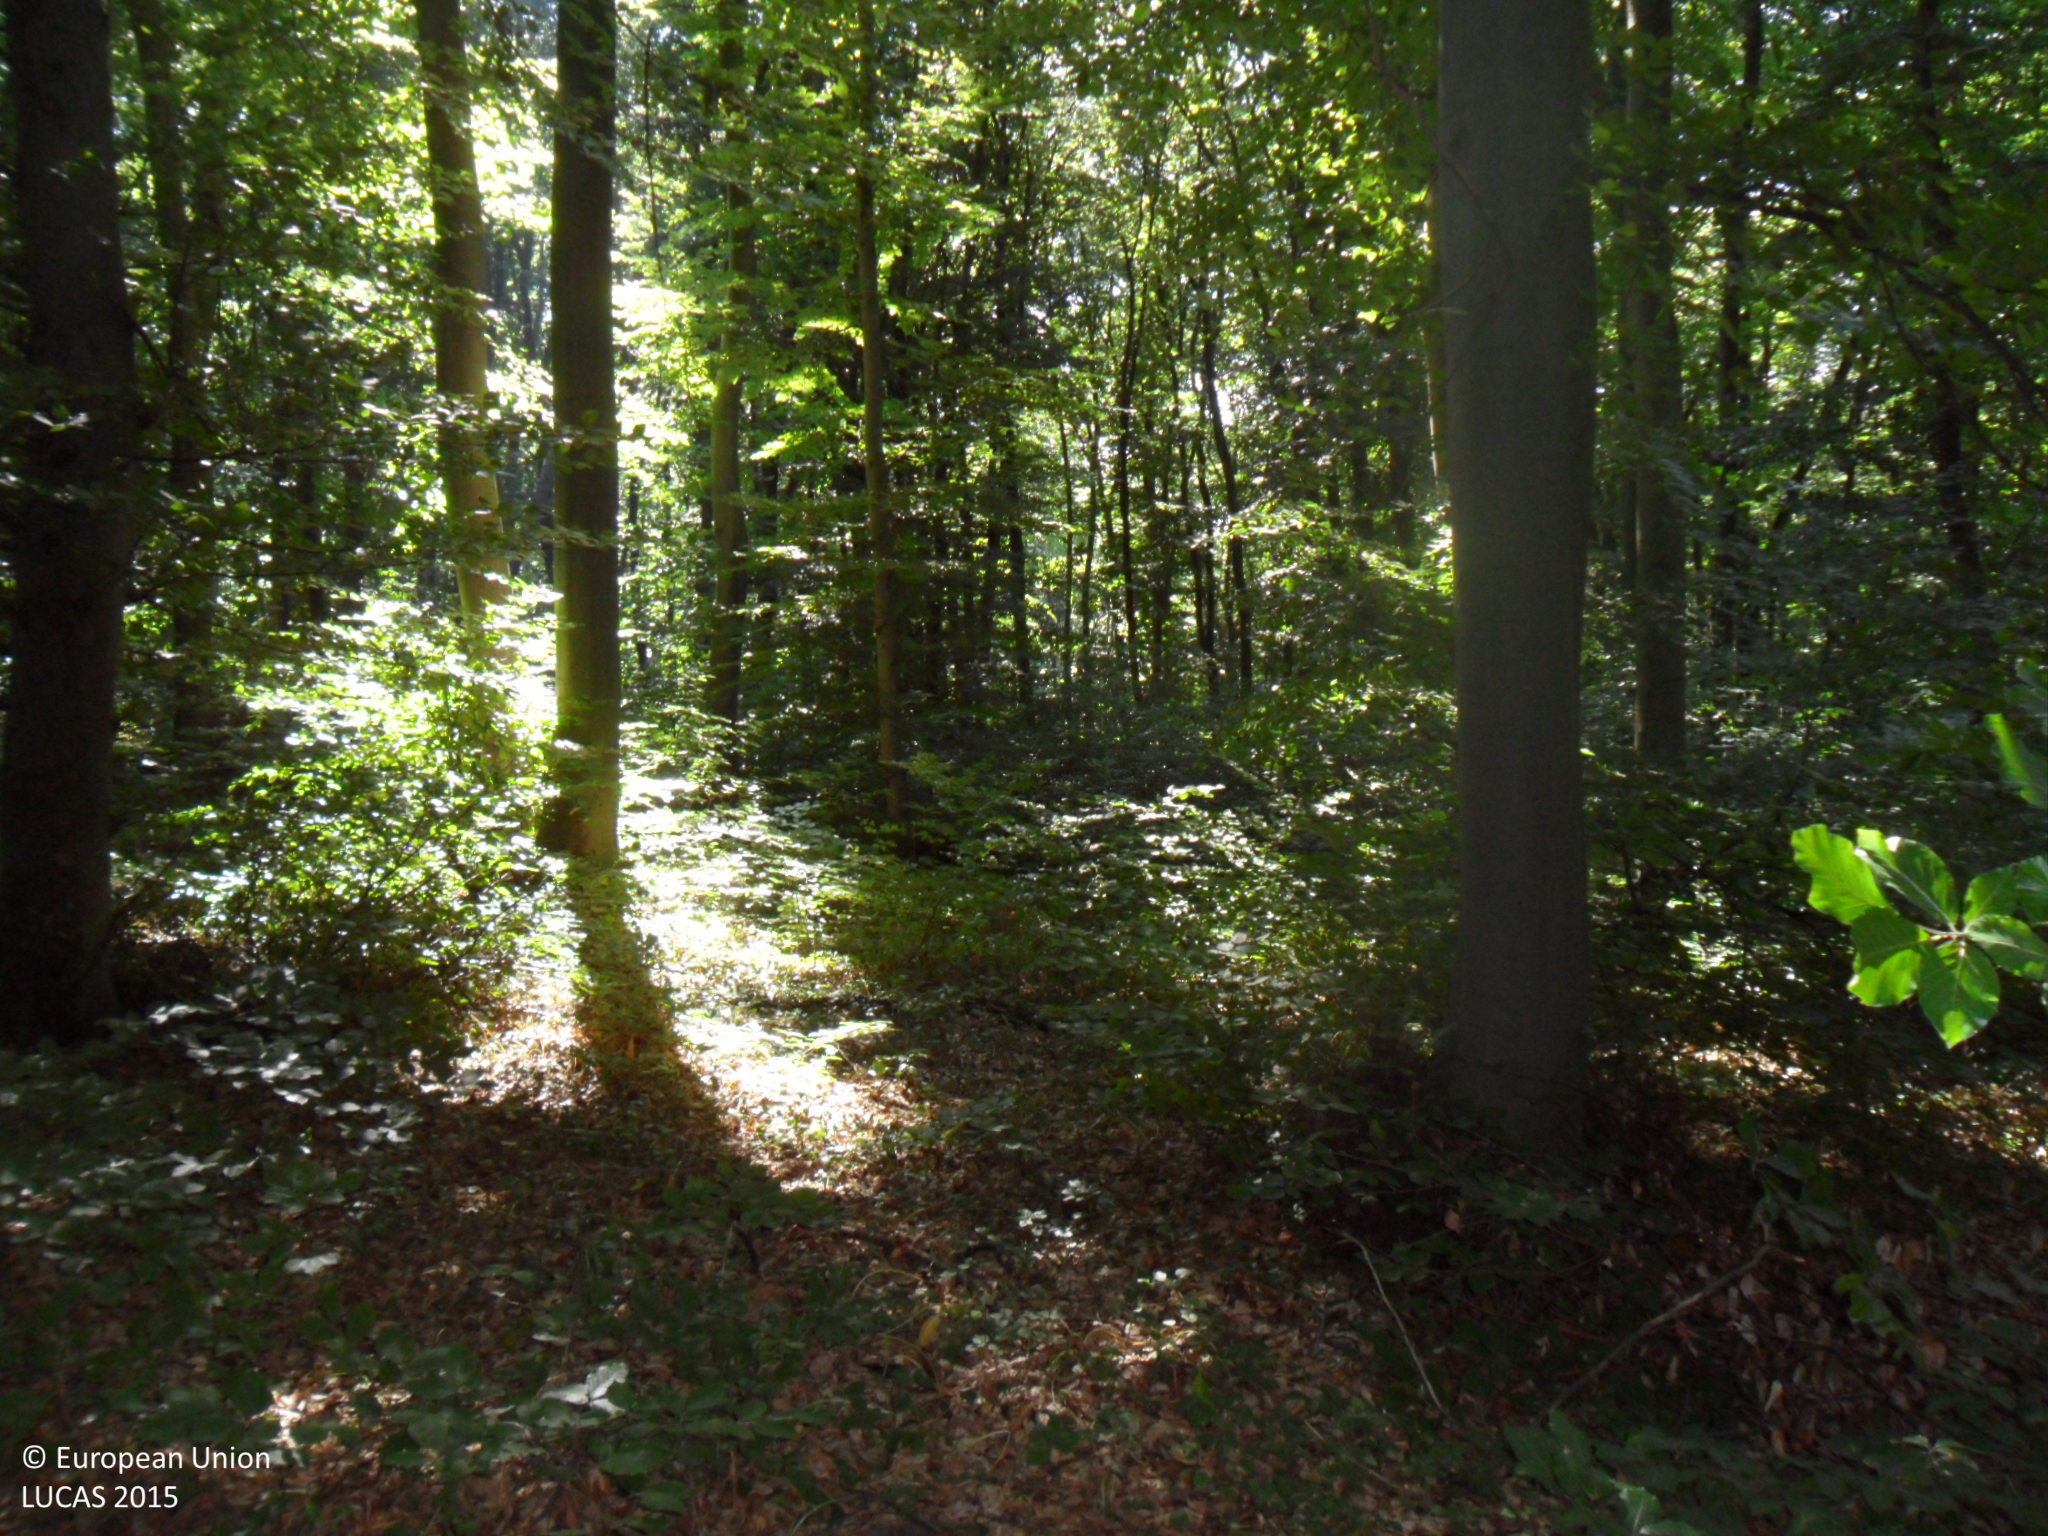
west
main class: Woodland
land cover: Broadleaved woodland
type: beech forest
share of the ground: > 75 %
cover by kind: broadleaved forest trees 95 %, shrubs 5 %
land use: Amenities, museums, leisure
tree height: > 5 m
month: June
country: BG
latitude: 43.2683
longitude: 26.8796
